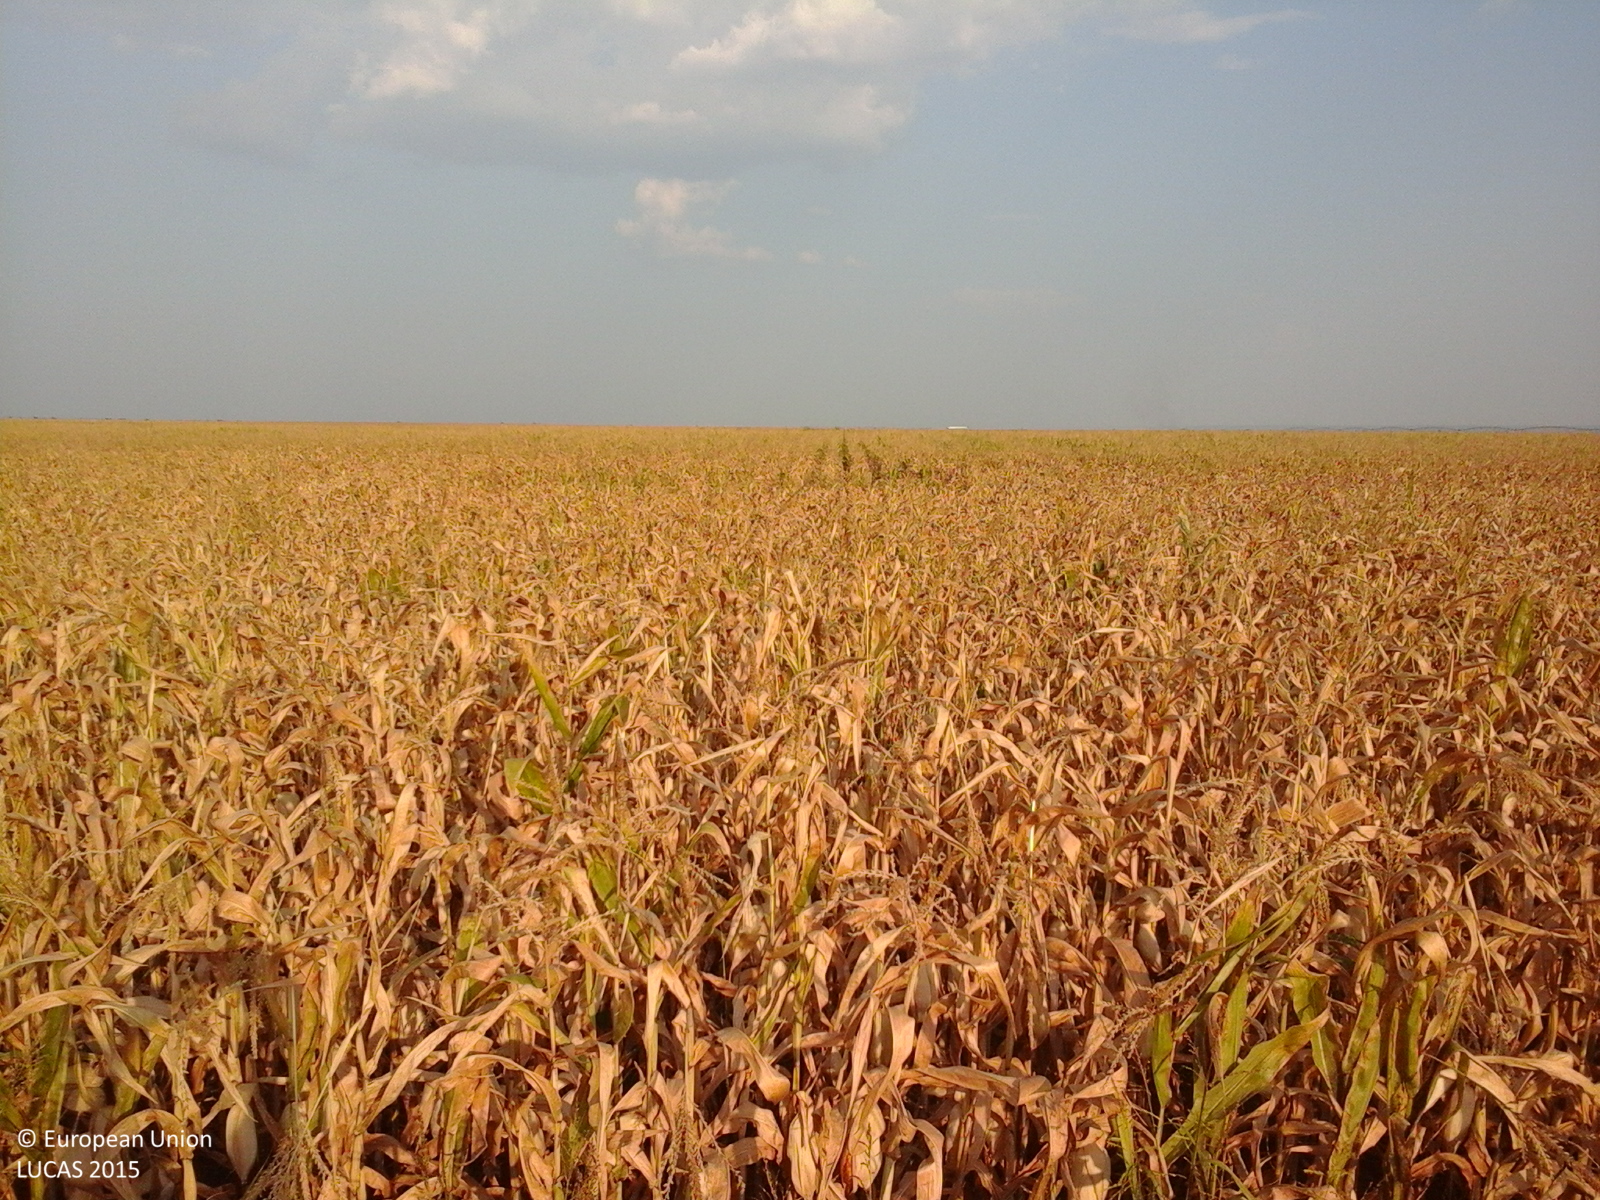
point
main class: Cropland
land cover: Maize
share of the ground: > 75 %
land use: Agriculture (excluding fallow land and kitchen gardens)
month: August
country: RO
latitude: 43.9783
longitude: 23.1962
